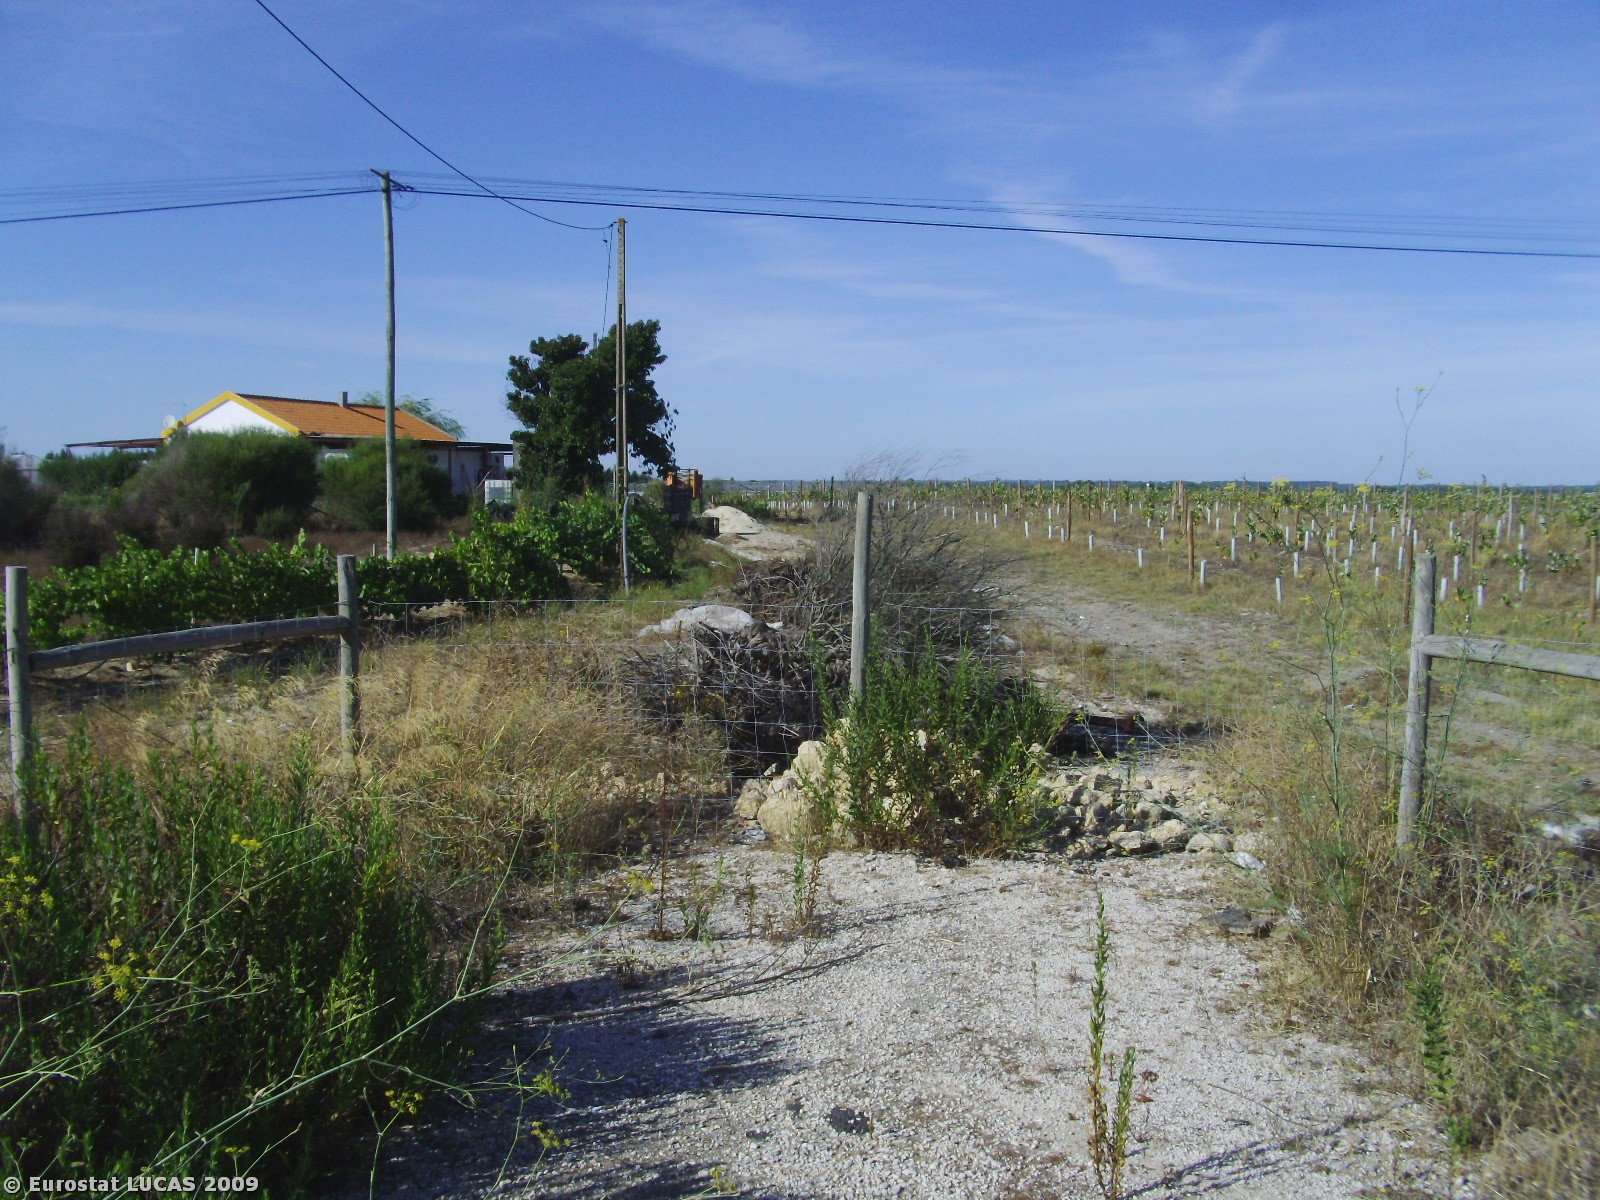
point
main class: Grassland
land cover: Spontaneously vegetated surfaces
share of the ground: > 75 %
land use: Fallow land
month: August
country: PT
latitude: 38.7228
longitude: -8.6368
